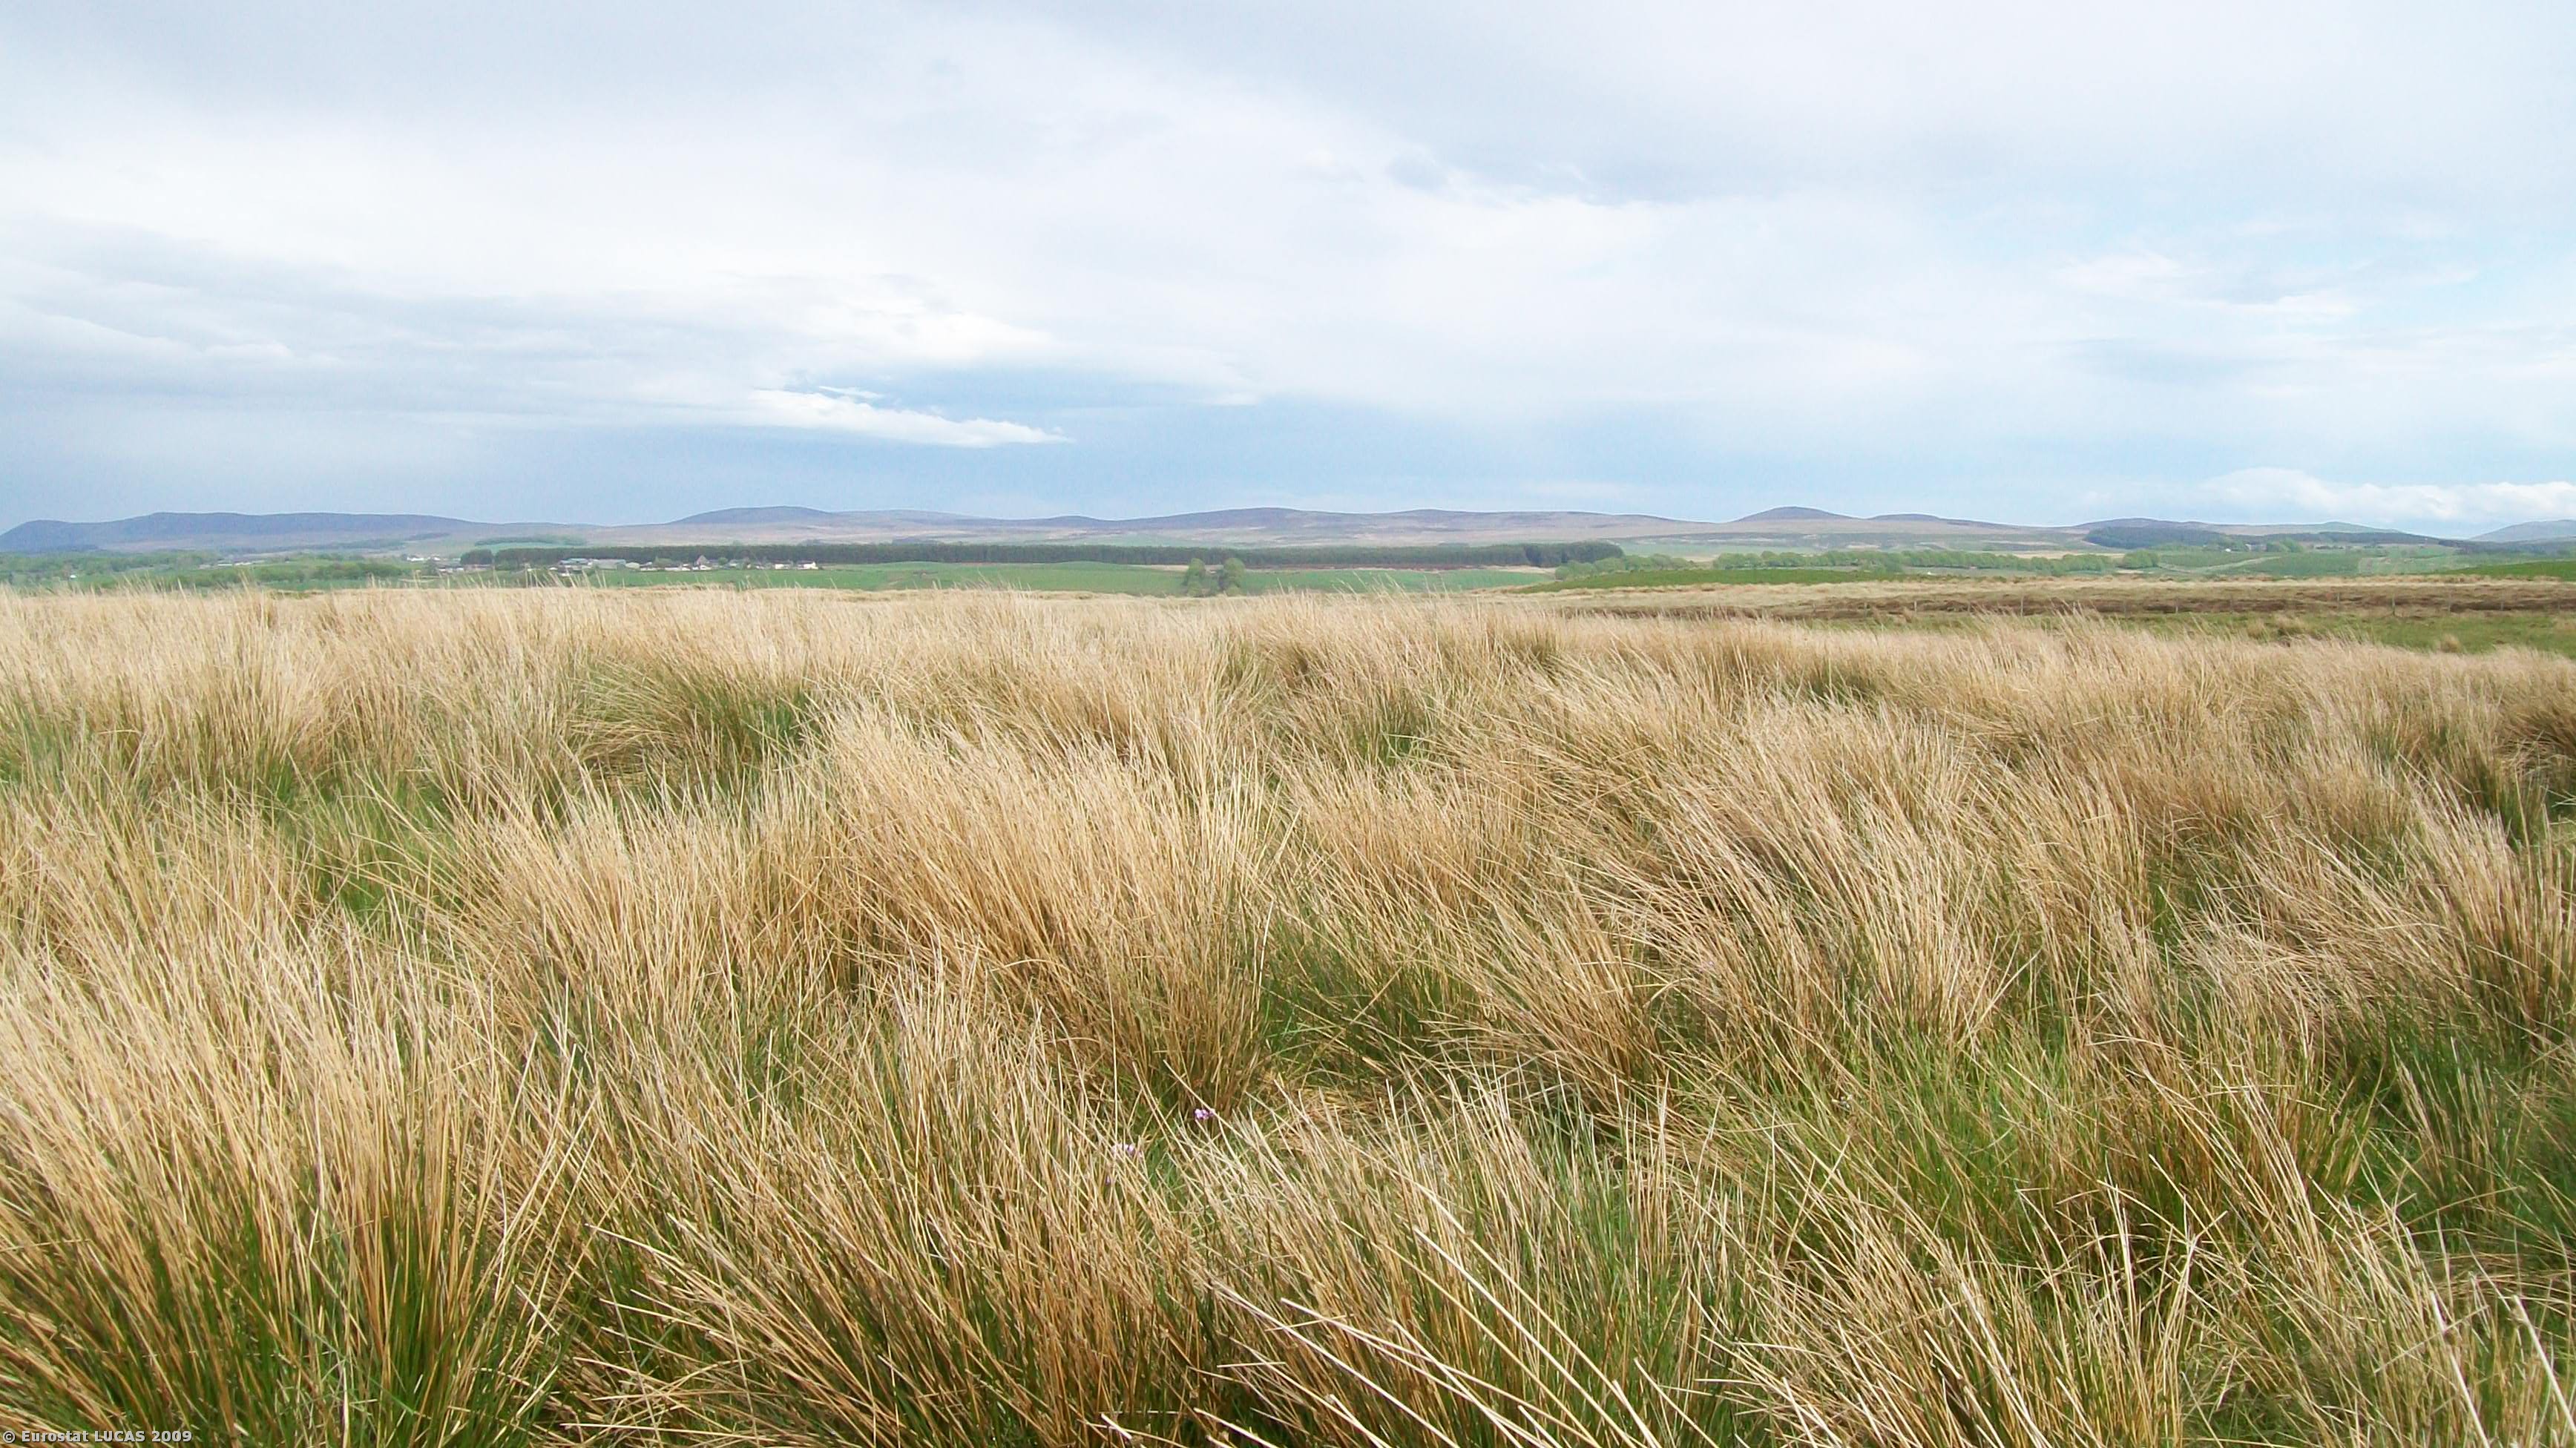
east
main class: Grassland
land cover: Grassland without tree/shrub cover
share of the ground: > 75 %
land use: Agriculture (excluding fallow land and kitchen gardens)
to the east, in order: Grassland without tree/shrub cover; Peatbogs; Fences; Shrubland without tree cover; Bare land
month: May
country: GB
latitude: 55.7648
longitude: -3.6441
